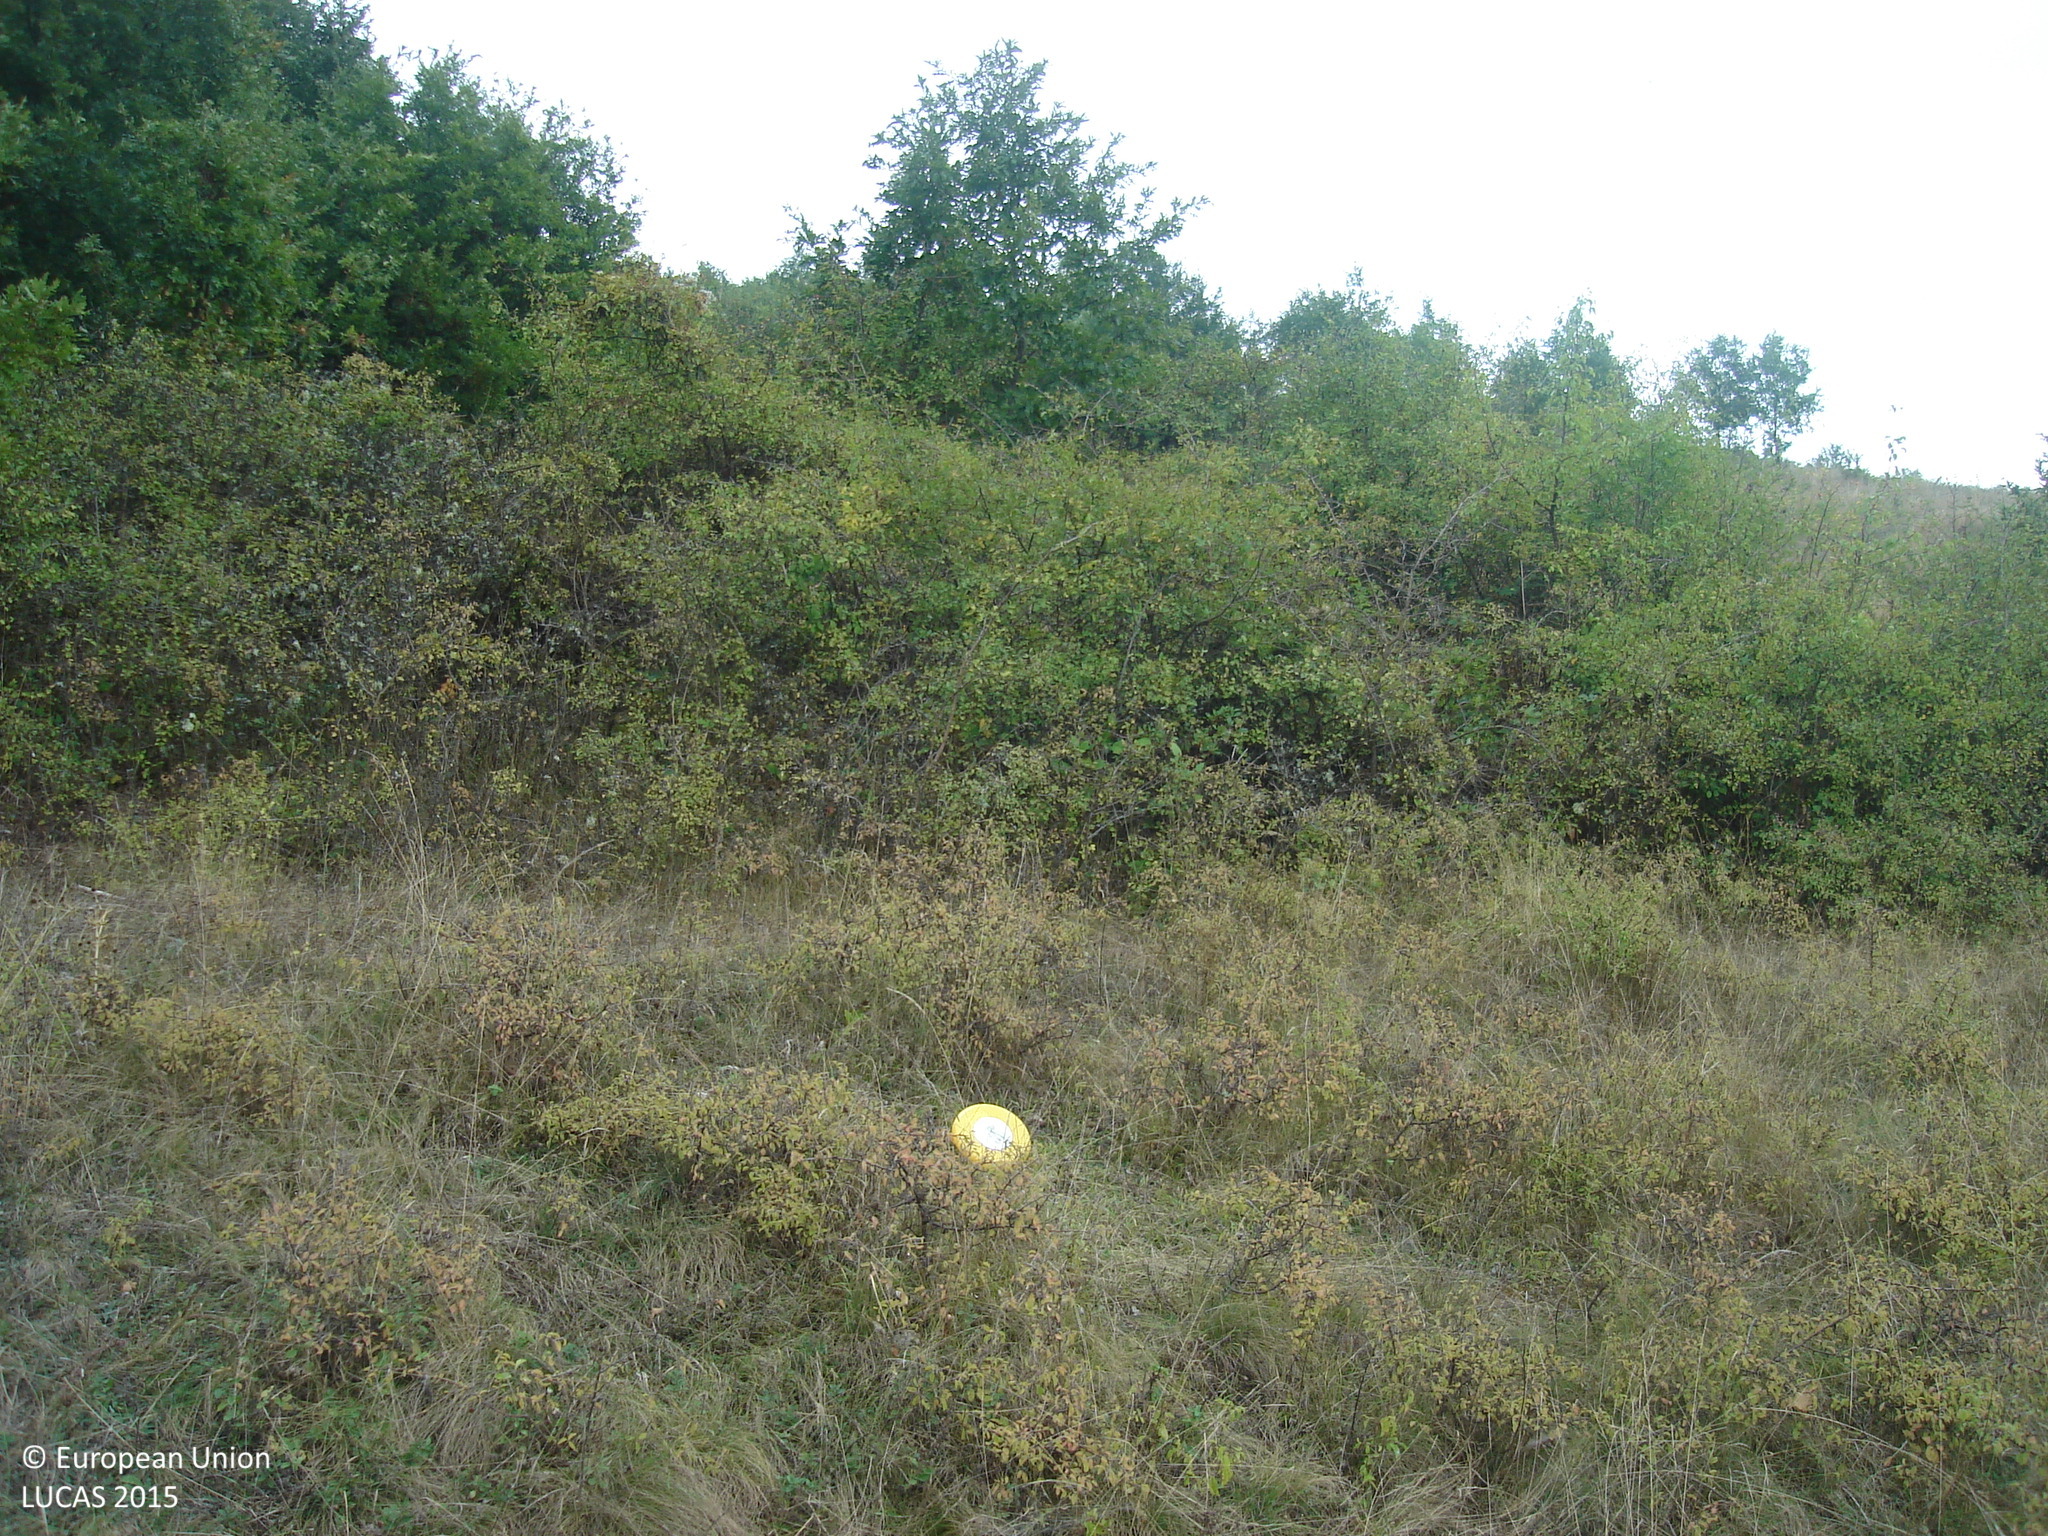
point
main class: Grassland
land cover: Grassland with sparse tree/shrub cover
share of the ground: > 75 %
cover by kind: herbaceous plants 85 %, shrubs 10 %, broadleaved forest trees 5 %
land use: Semi-natural and natural areas not in use
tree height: < 5 m
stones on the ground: < 10 %
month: September
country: BG
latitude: 42.9796
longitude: 23.2926
